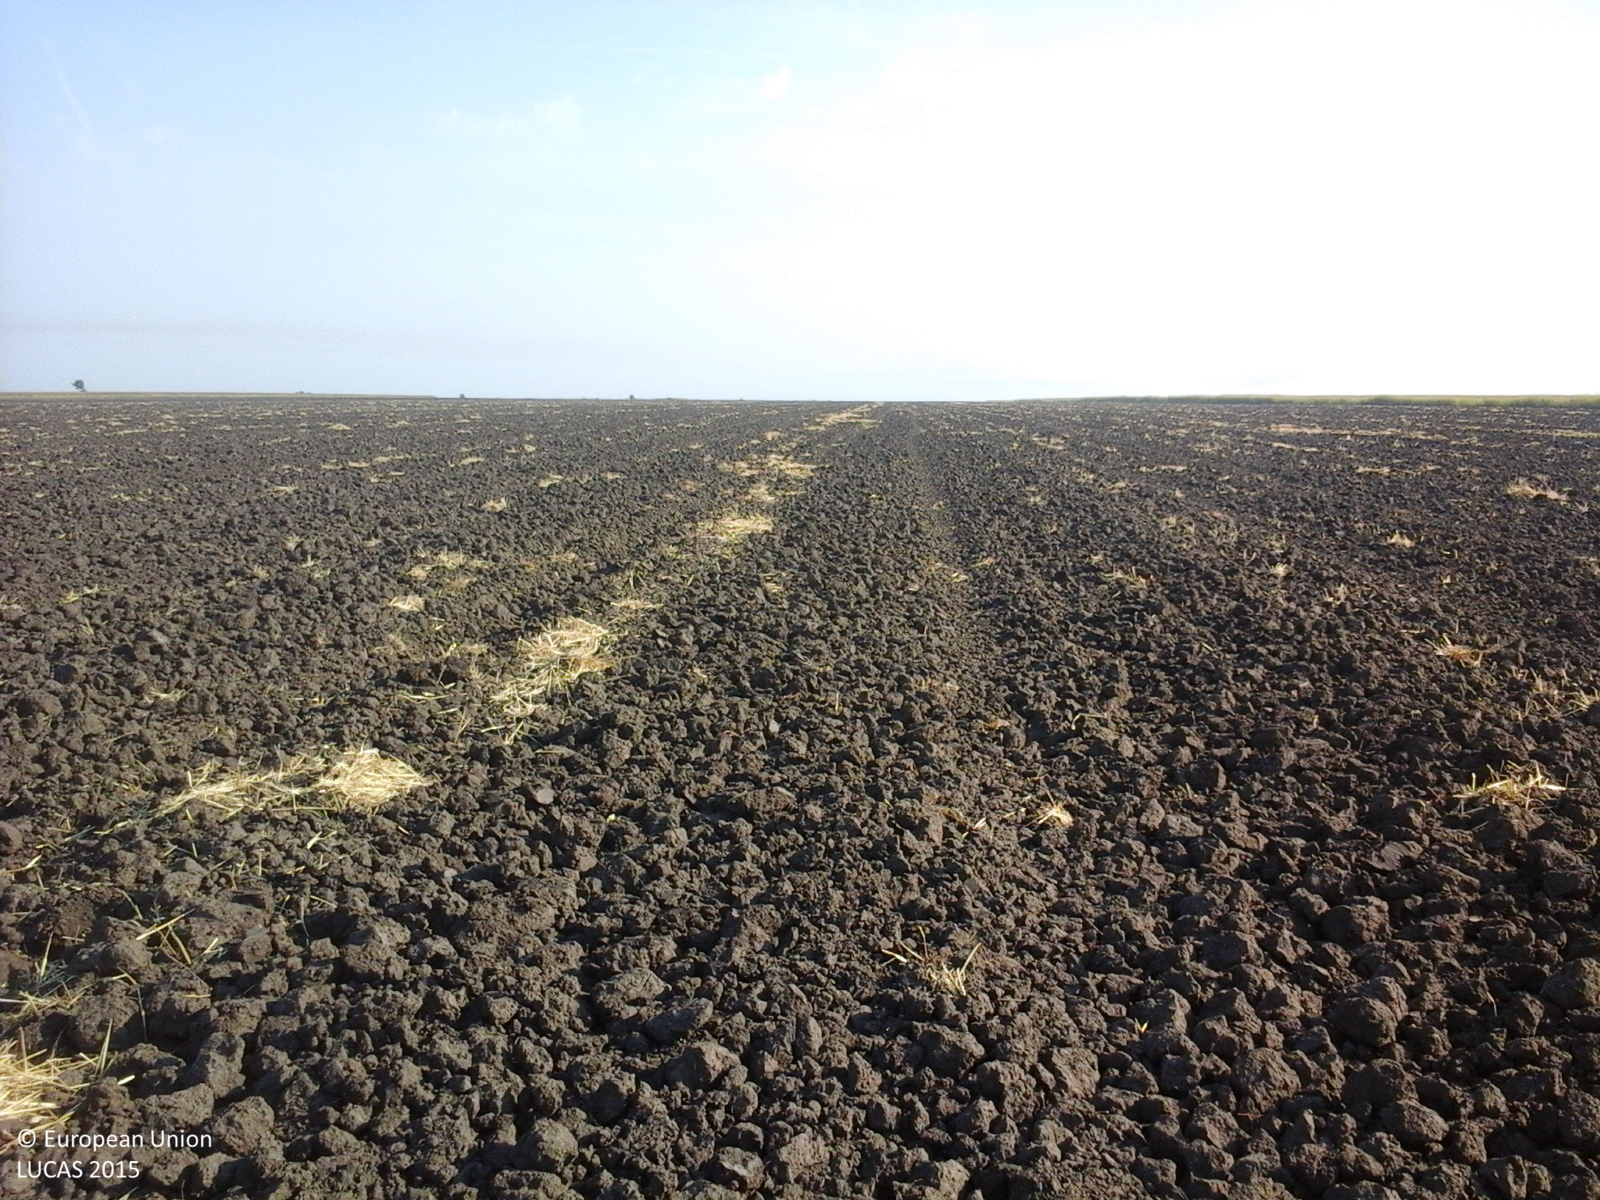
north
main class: Cropland
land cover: Common wheat
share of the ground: < 10 %
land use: Agriculture (excluding fallow land and kitchen gardens)
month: August
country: RO
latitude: 43.9990
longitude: 23.7332
